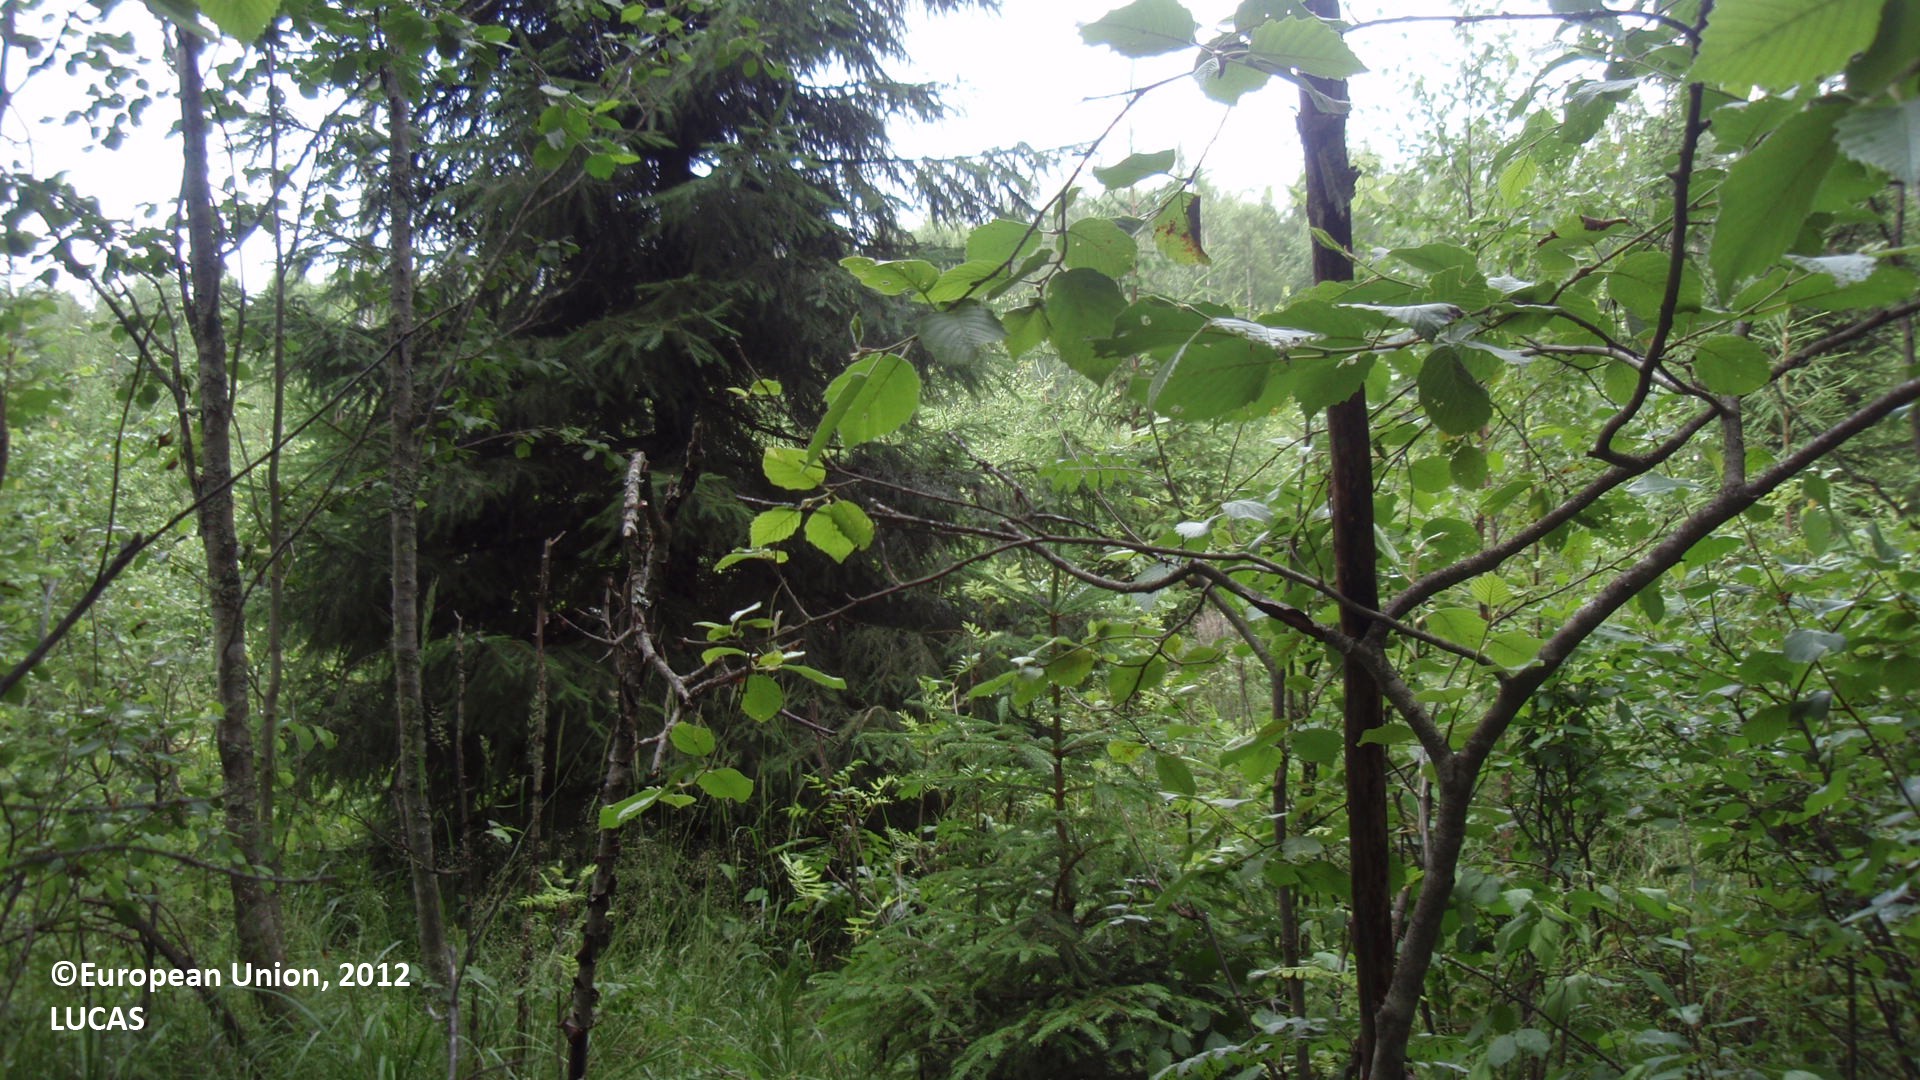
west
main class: Woodland
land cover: Broadleaved woodland
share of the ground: > 75 %
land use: Forestry
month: July
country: FI
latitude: 61.4809
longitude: 27.1973
